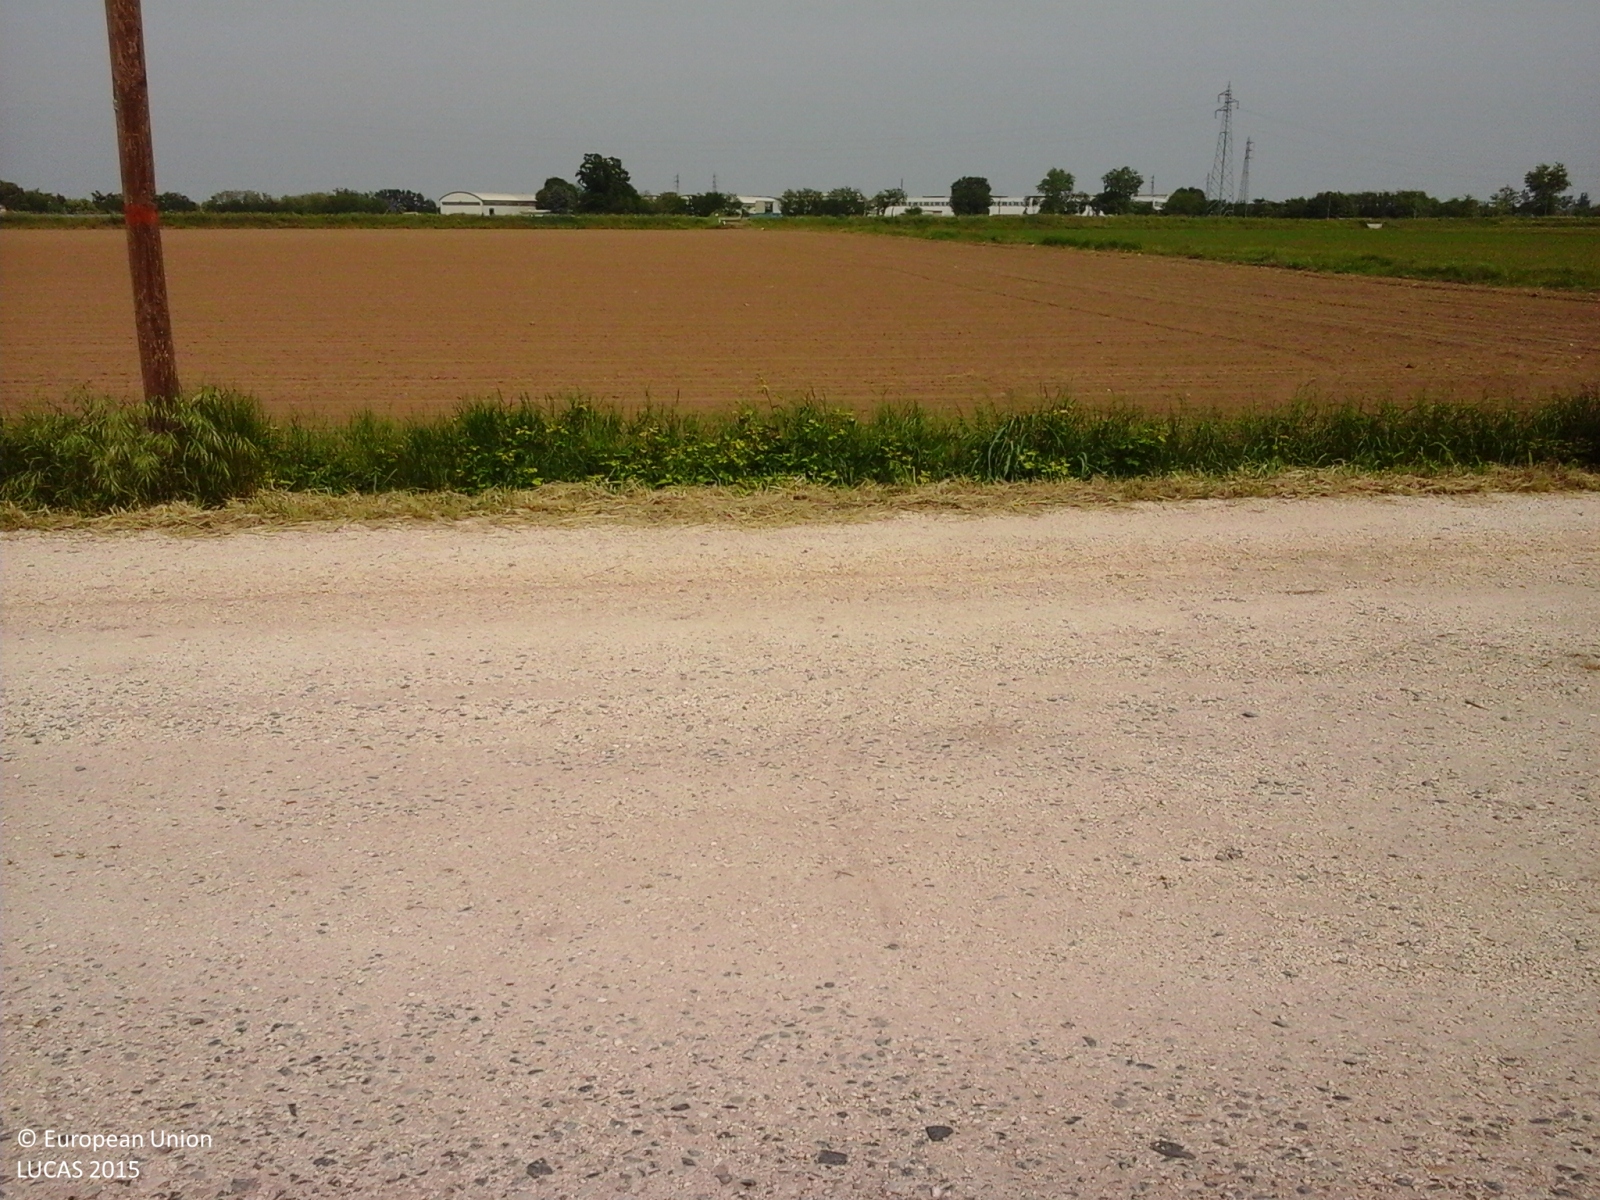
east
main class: Cropland
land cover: Barley
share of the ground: > 75 %
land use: Agriculture (excluding fallow land and kitchen gardens)
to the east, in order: Barley; Fences; Managed hedges; Grassland without tree/shrub cover; Paved roads, cycling and walking lanes; Grass margins; Electric lines; Ditches and canals; Grass margins; Soya; Grass margins; Ditches and canals; Grass margins; Maize
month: May
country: IT
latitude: 45.2520
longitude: 10.0636
